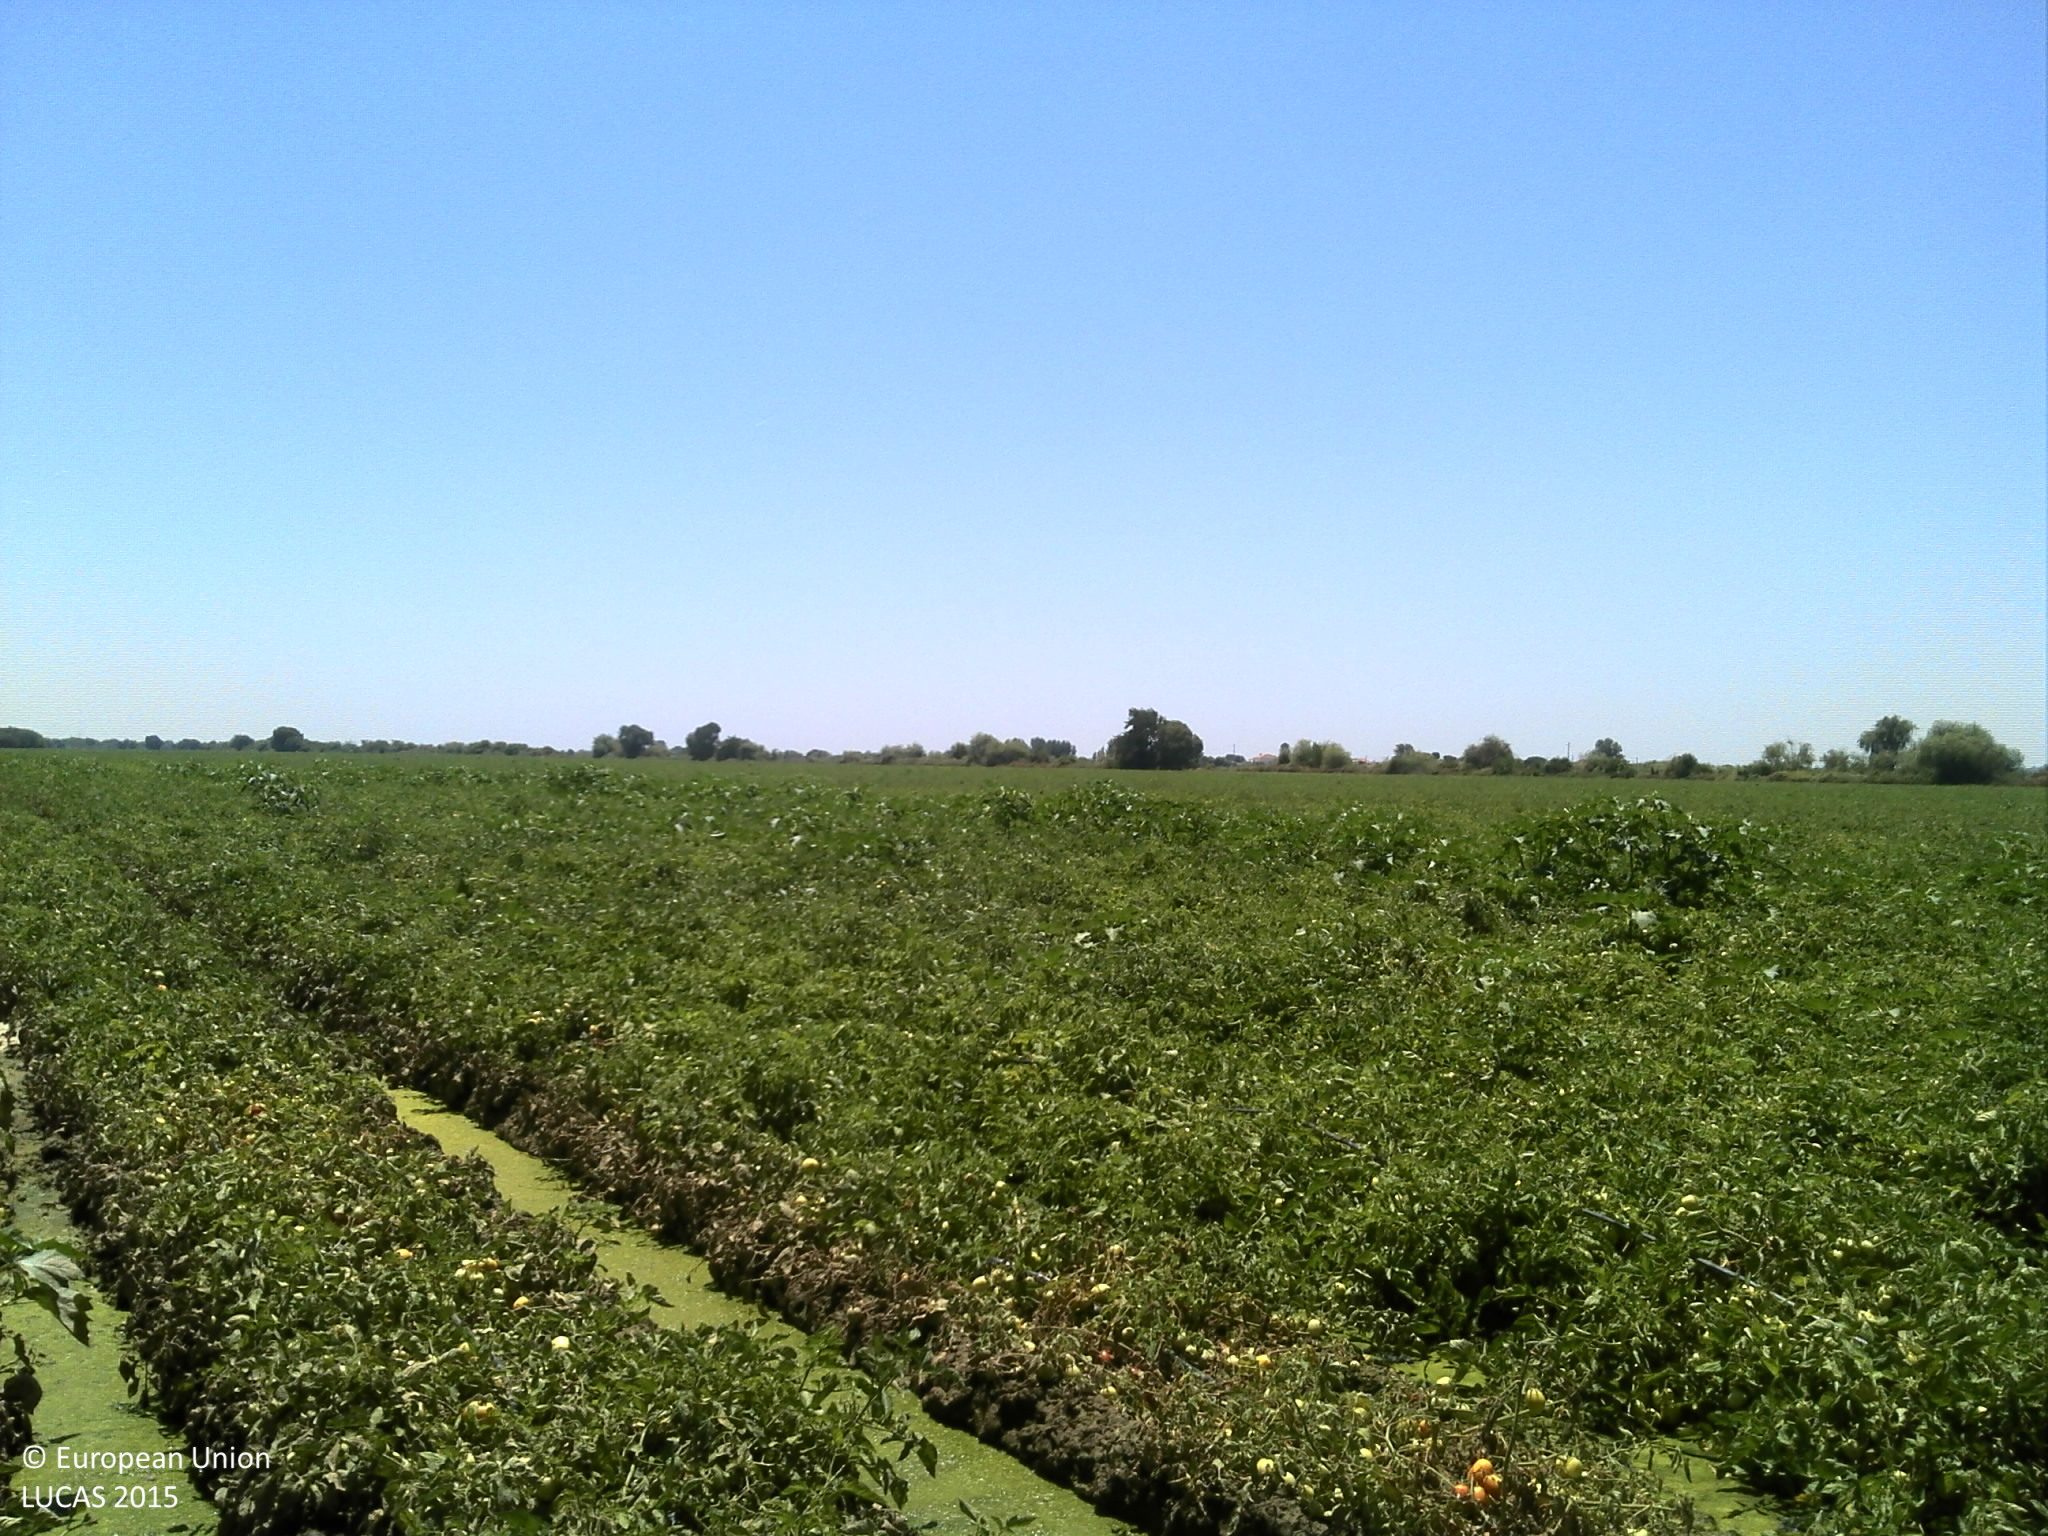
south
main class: Cropland
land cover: Tomatoes
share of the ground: > 75 %
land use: Agriculture (excluding fallow land and kitchen gardens)
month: June
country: PT
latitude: 39.1959
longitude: -8.6786
